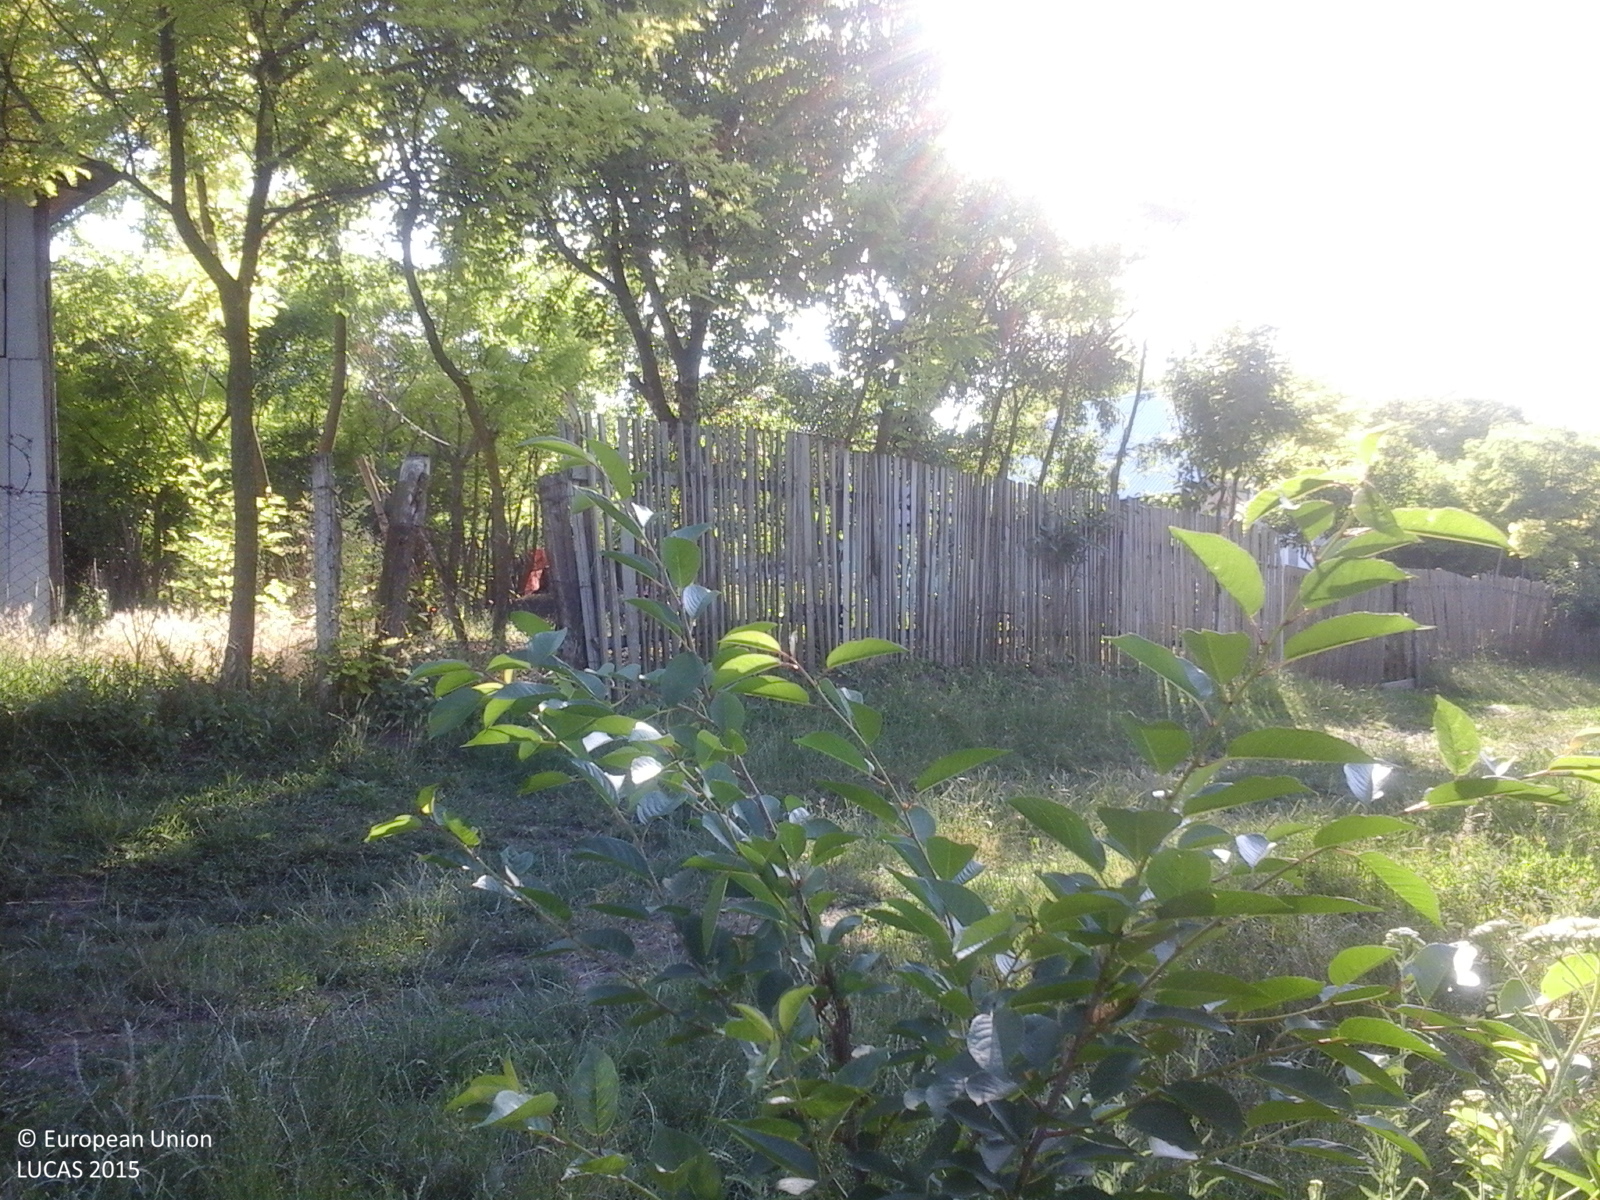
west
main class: Woodland
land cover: Broadleaved woodland
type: broadleaved evergreen forest
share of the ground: > 75 %
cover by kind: broadleaved forest trees 100 %
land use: Forestry
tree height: > 5 m
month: June
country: RO
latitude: 47.7551
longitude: 27.2266
